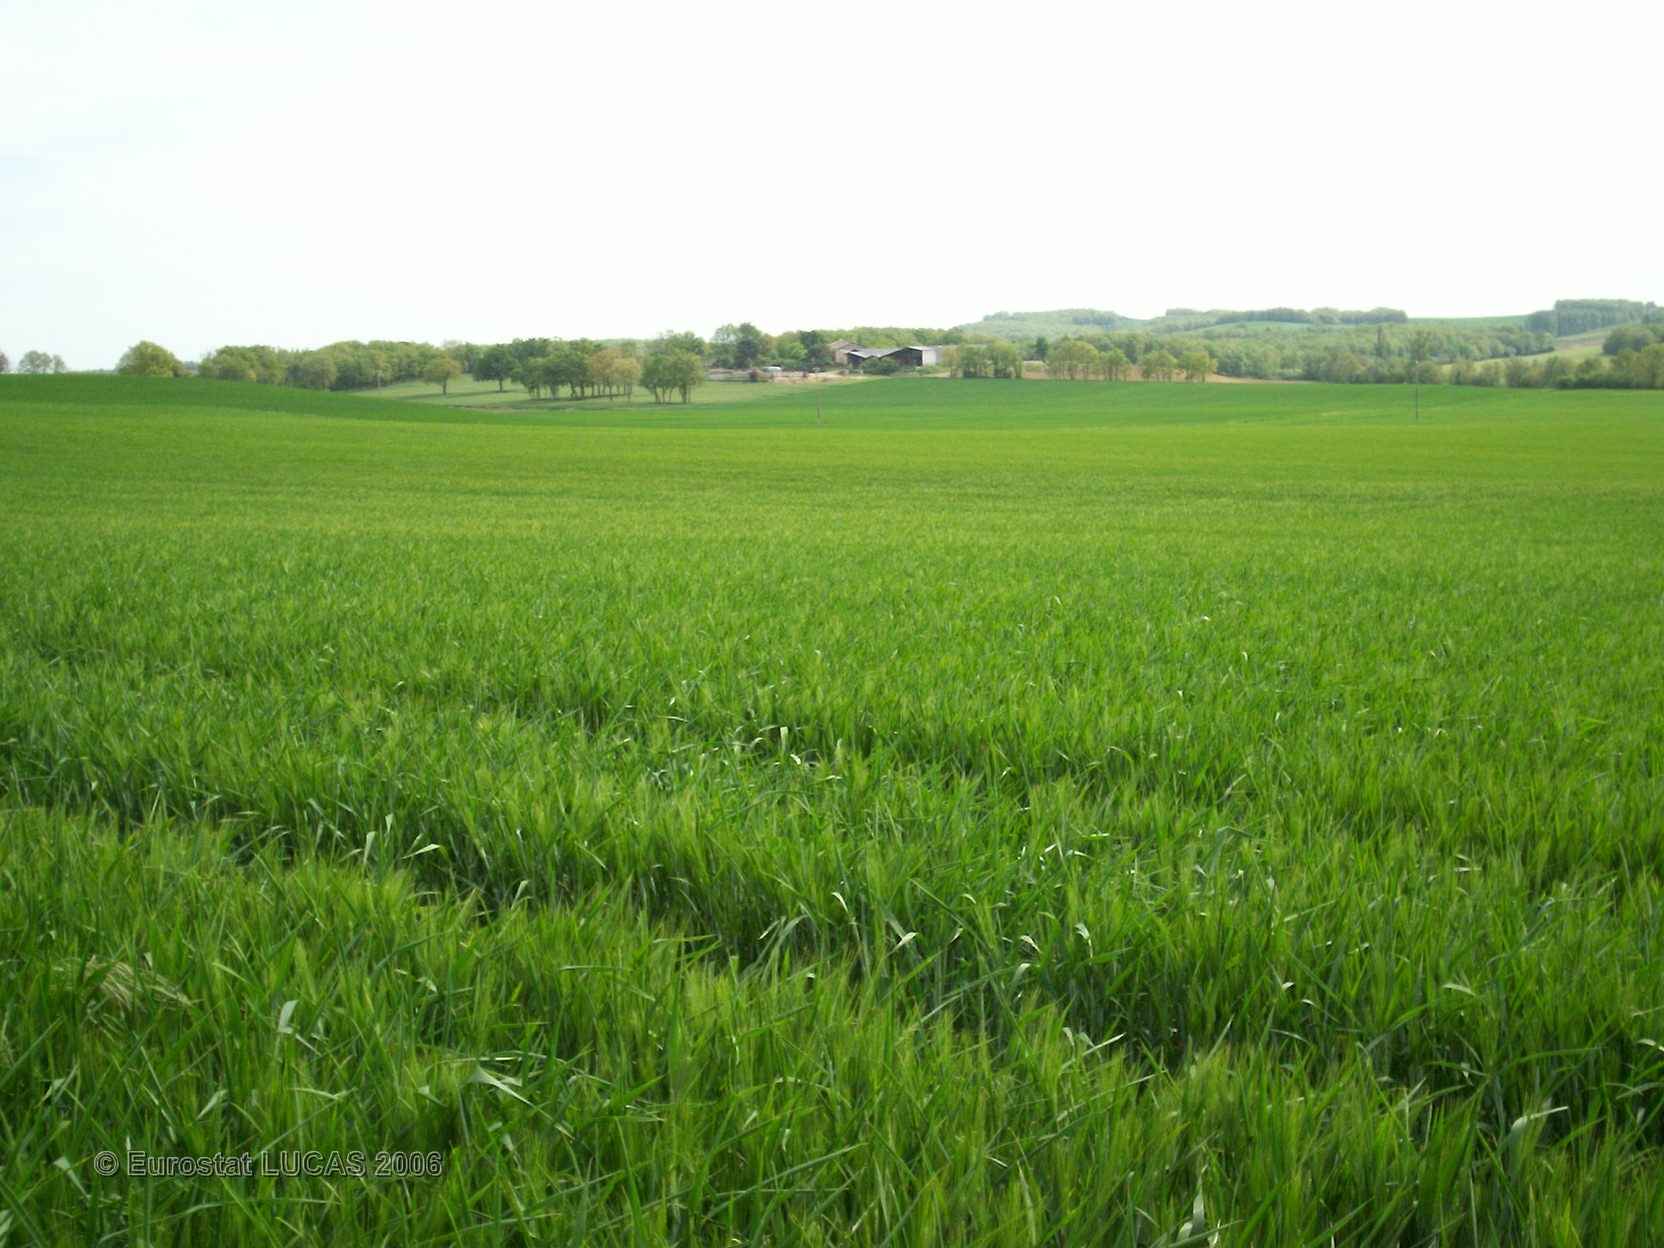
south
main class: Cropland
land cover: Durum wheat
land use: Agriculture (excluding fallow land and kitchen gardens)
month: May
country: FR
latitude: 43.8425
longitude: 2.0061
